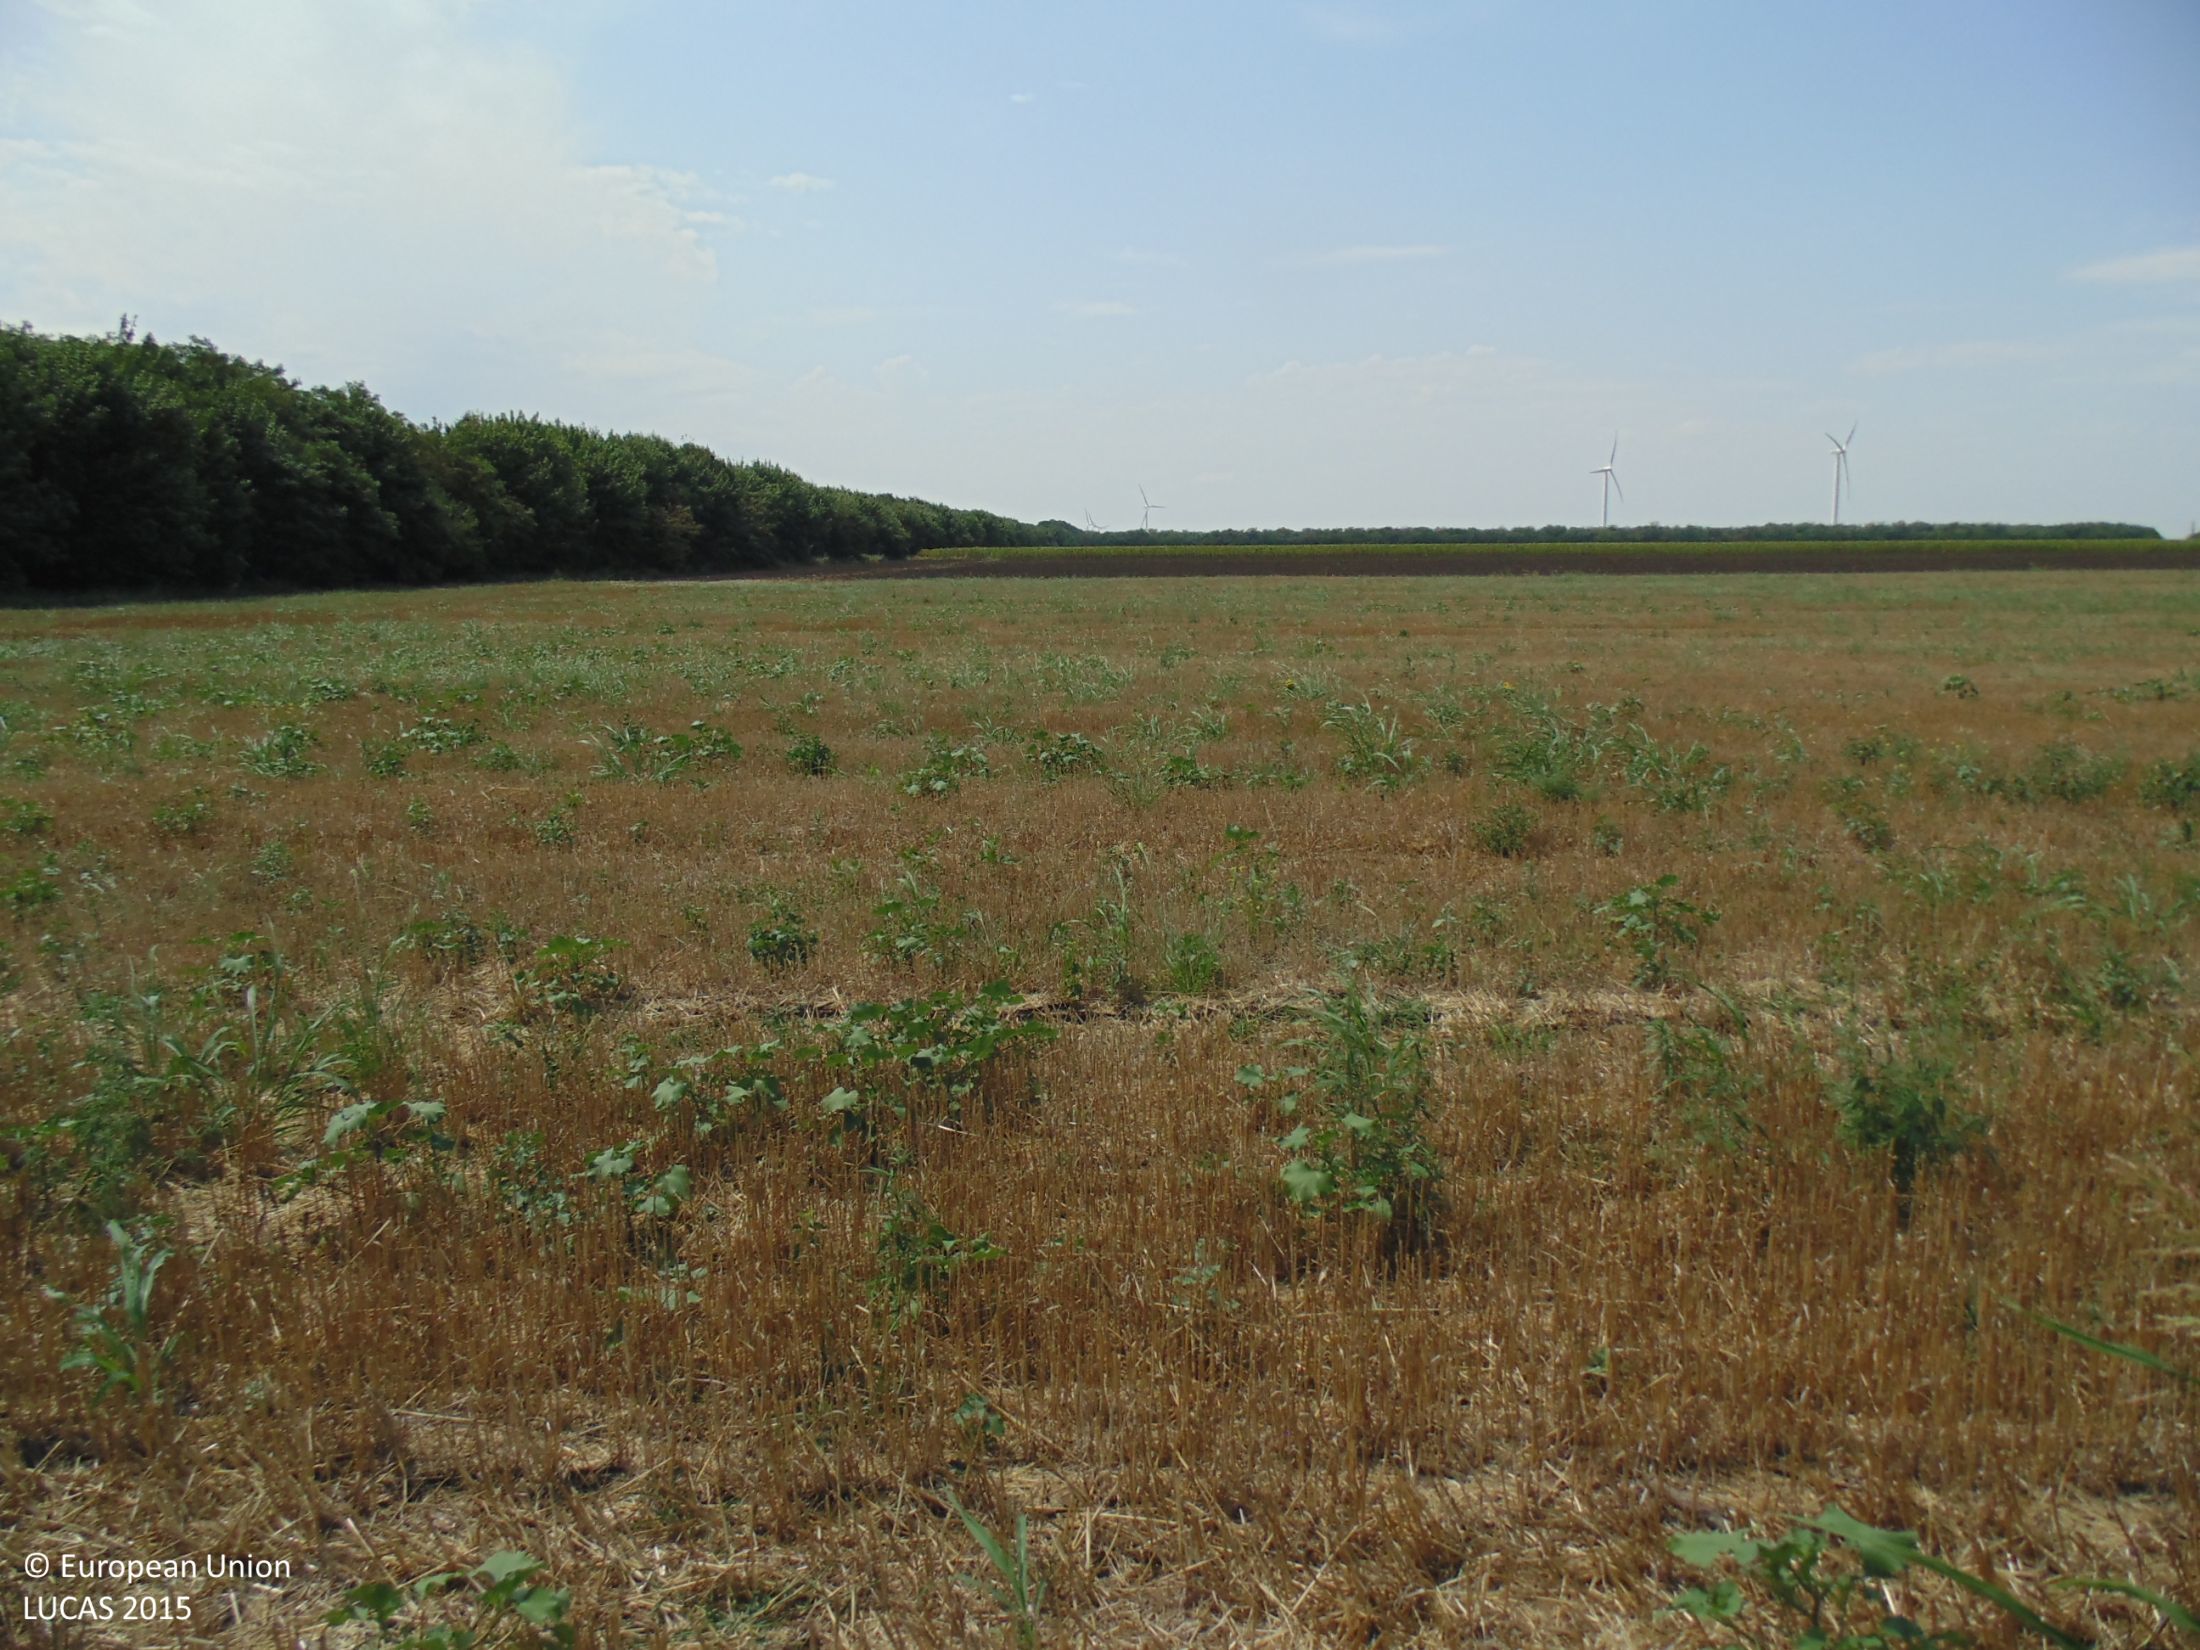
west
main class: Cropland
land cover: Common wheat
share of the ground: 25 - 50 %
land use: Agriculture (excluding fallow land and kitchen gardens)
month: August
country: BG
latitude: 43.7443
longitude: 28.1720
